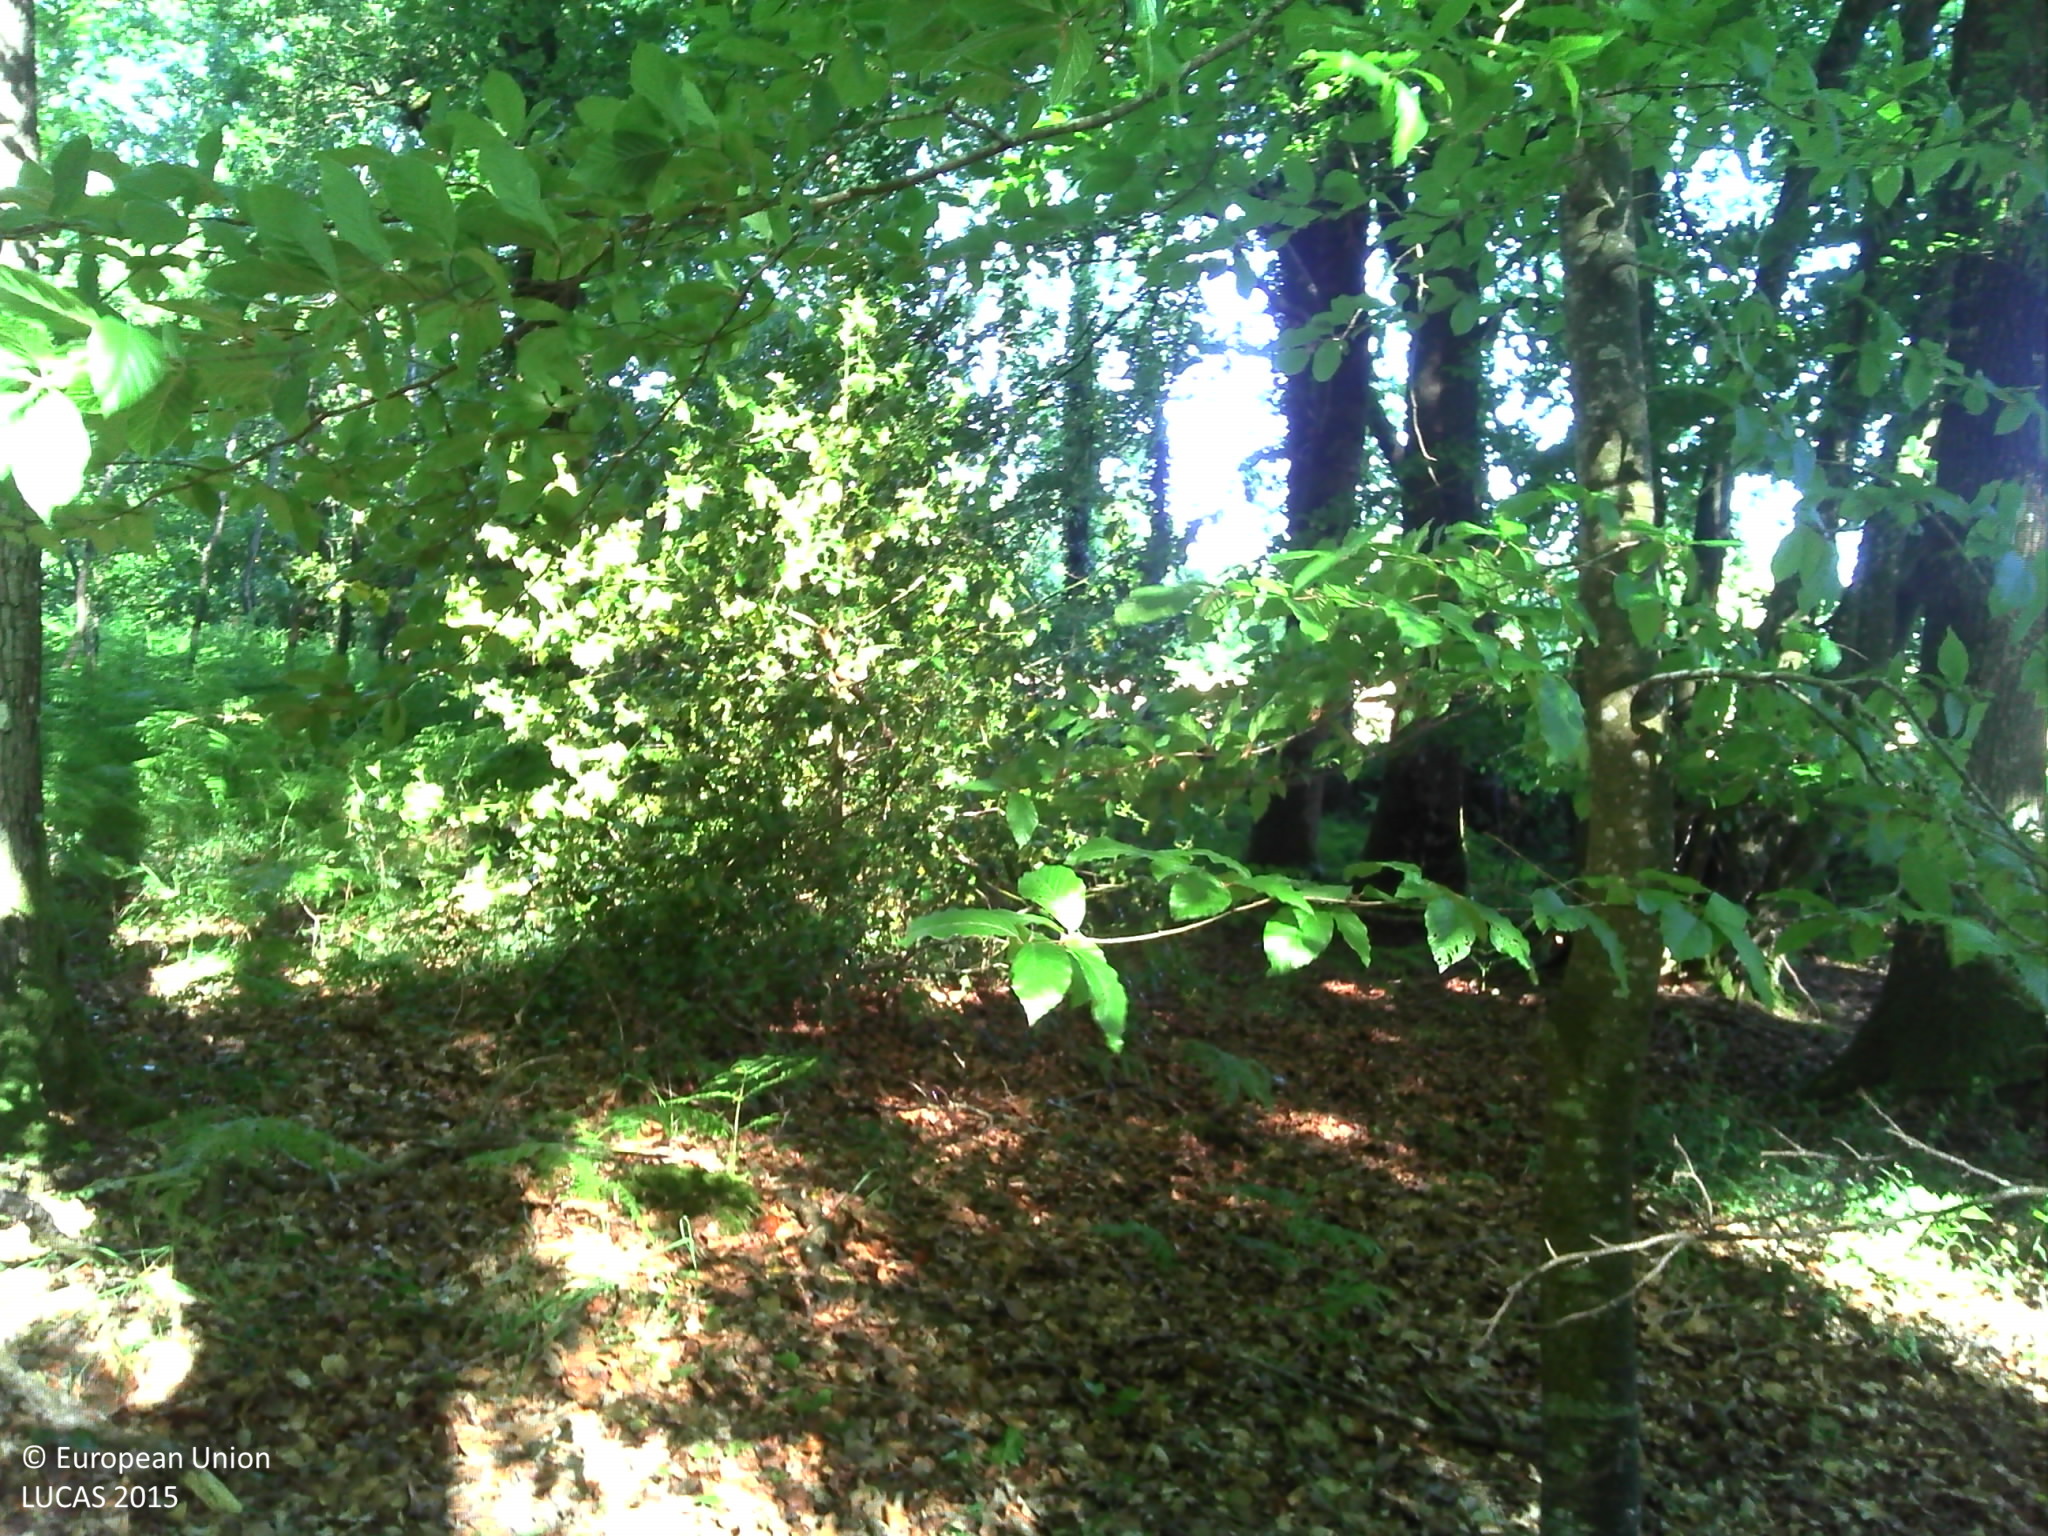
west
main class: Woodland
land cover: Broadleaved woodland
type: acidophilous oak and oak-birch forest
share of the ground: > 75 %
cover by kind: broadleaved forest trees 90 %, herbaceous plants 10 %
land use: Forestry
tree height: > 5 m
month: June
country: FR
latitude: 48.2113
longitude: -1.2256
